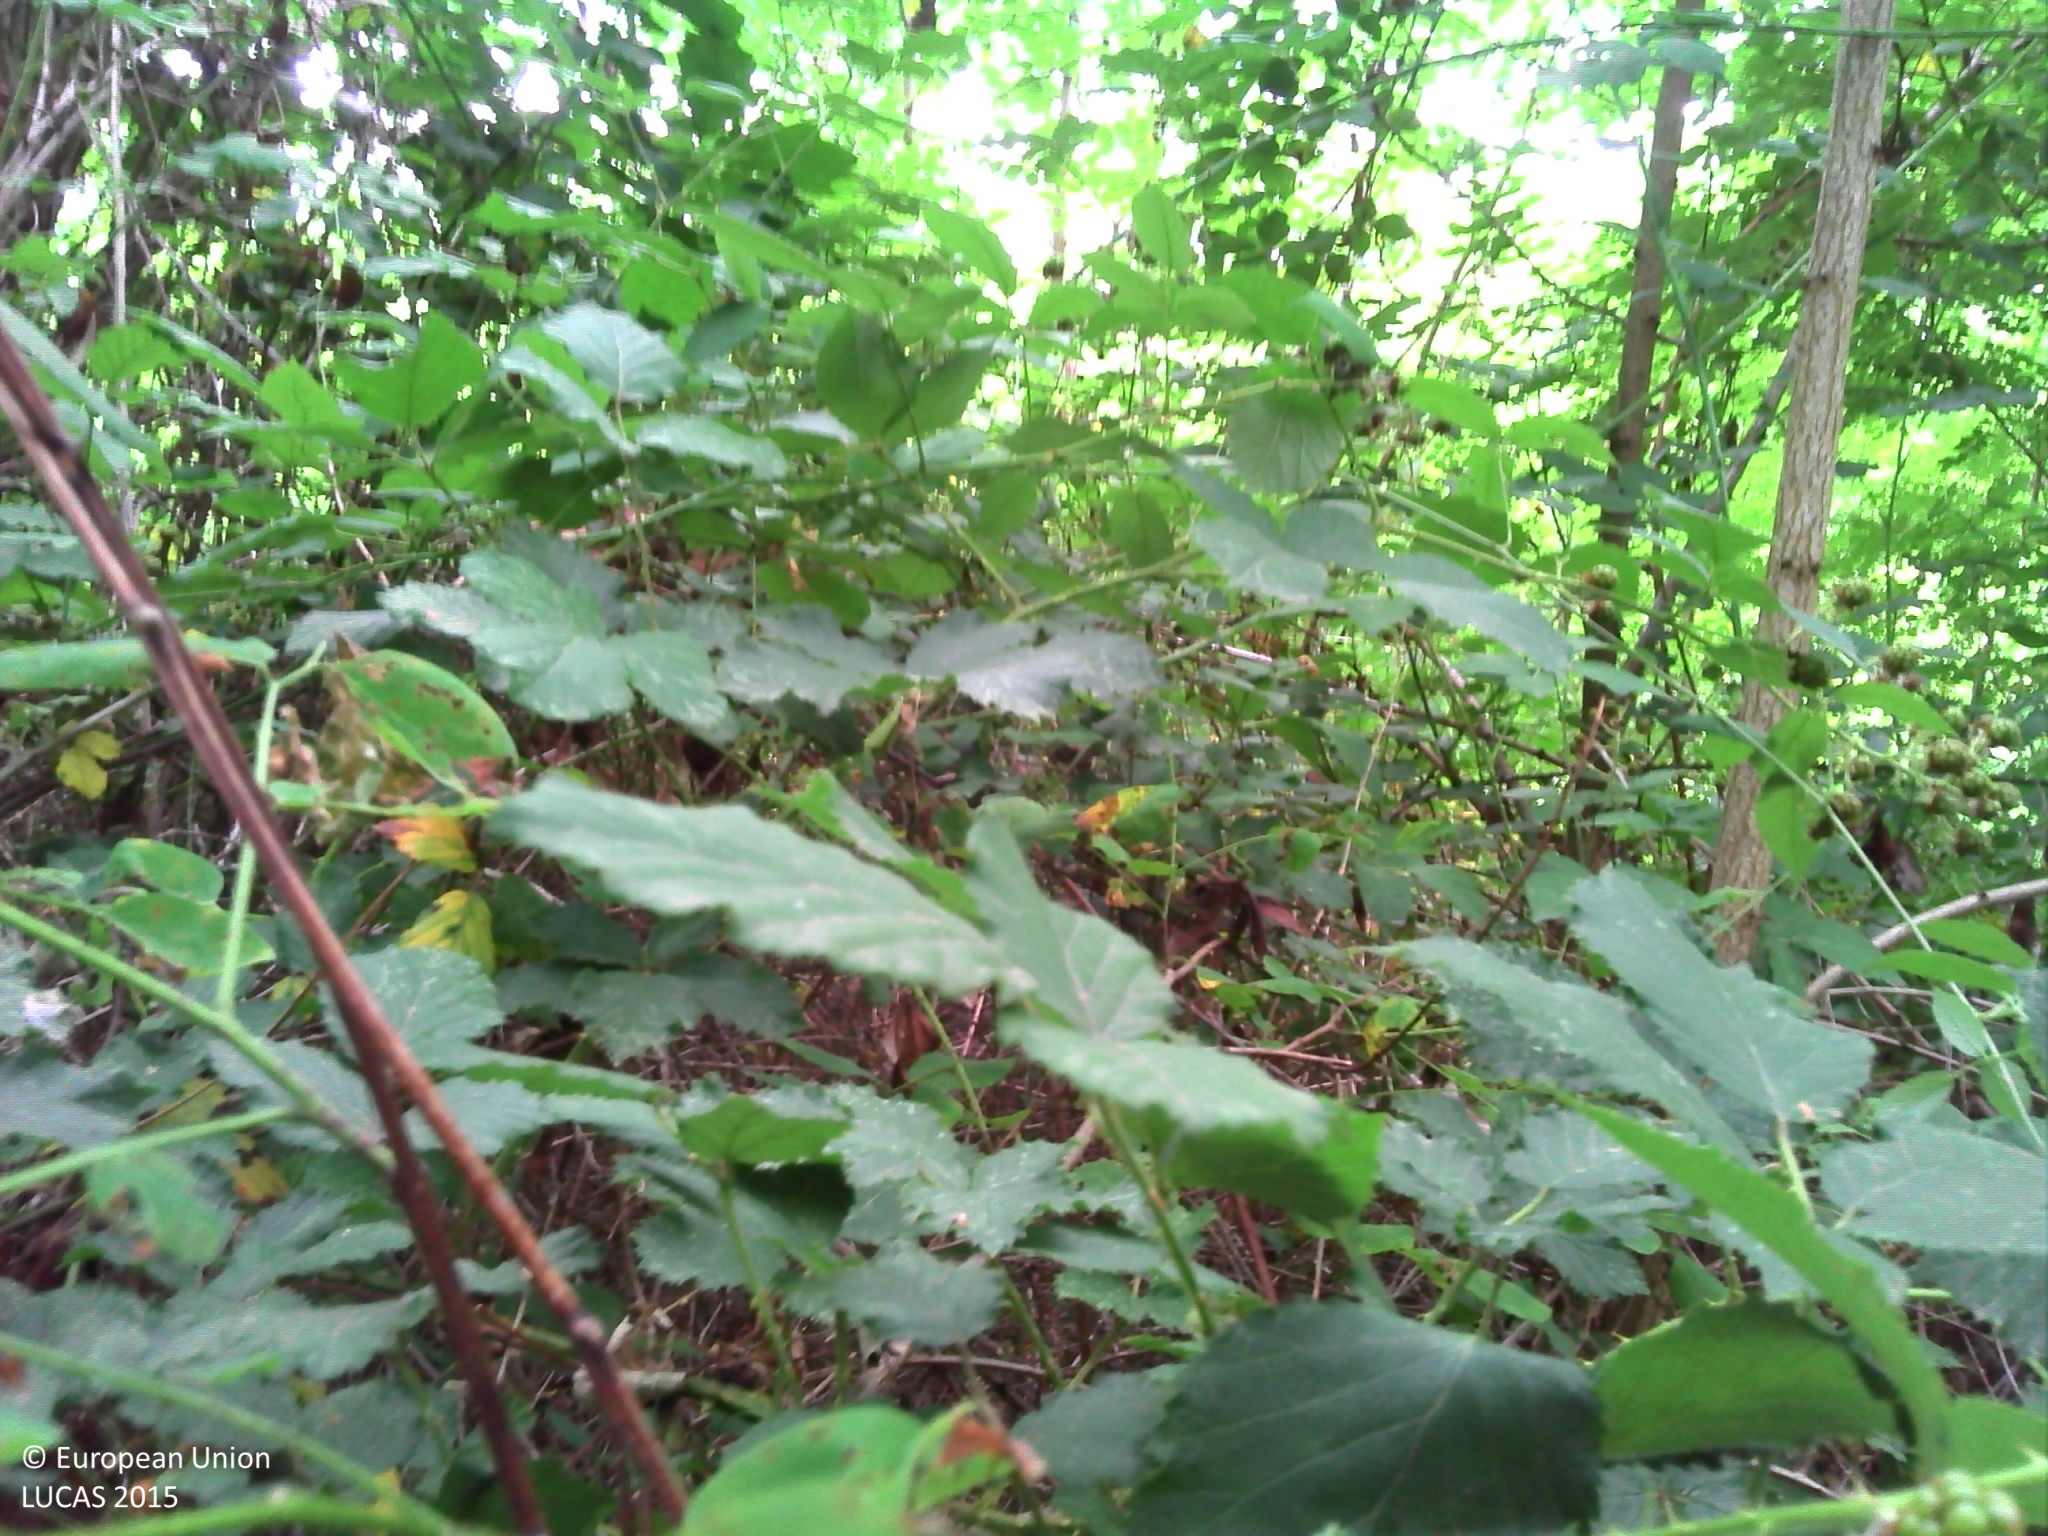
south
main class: Woodland
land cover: Pine dominated mixed woodland
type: coniferous forest of the mediterranean region
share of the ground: > 75 %
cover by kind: coniferous forest trees 30 %, broadleaved forest trees 30 %, shrubs 20 %, herbaceous plants 20 %
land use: Forestry
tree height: > 5 m
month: July
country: FR
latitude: 44.9703
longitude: 0.5439
